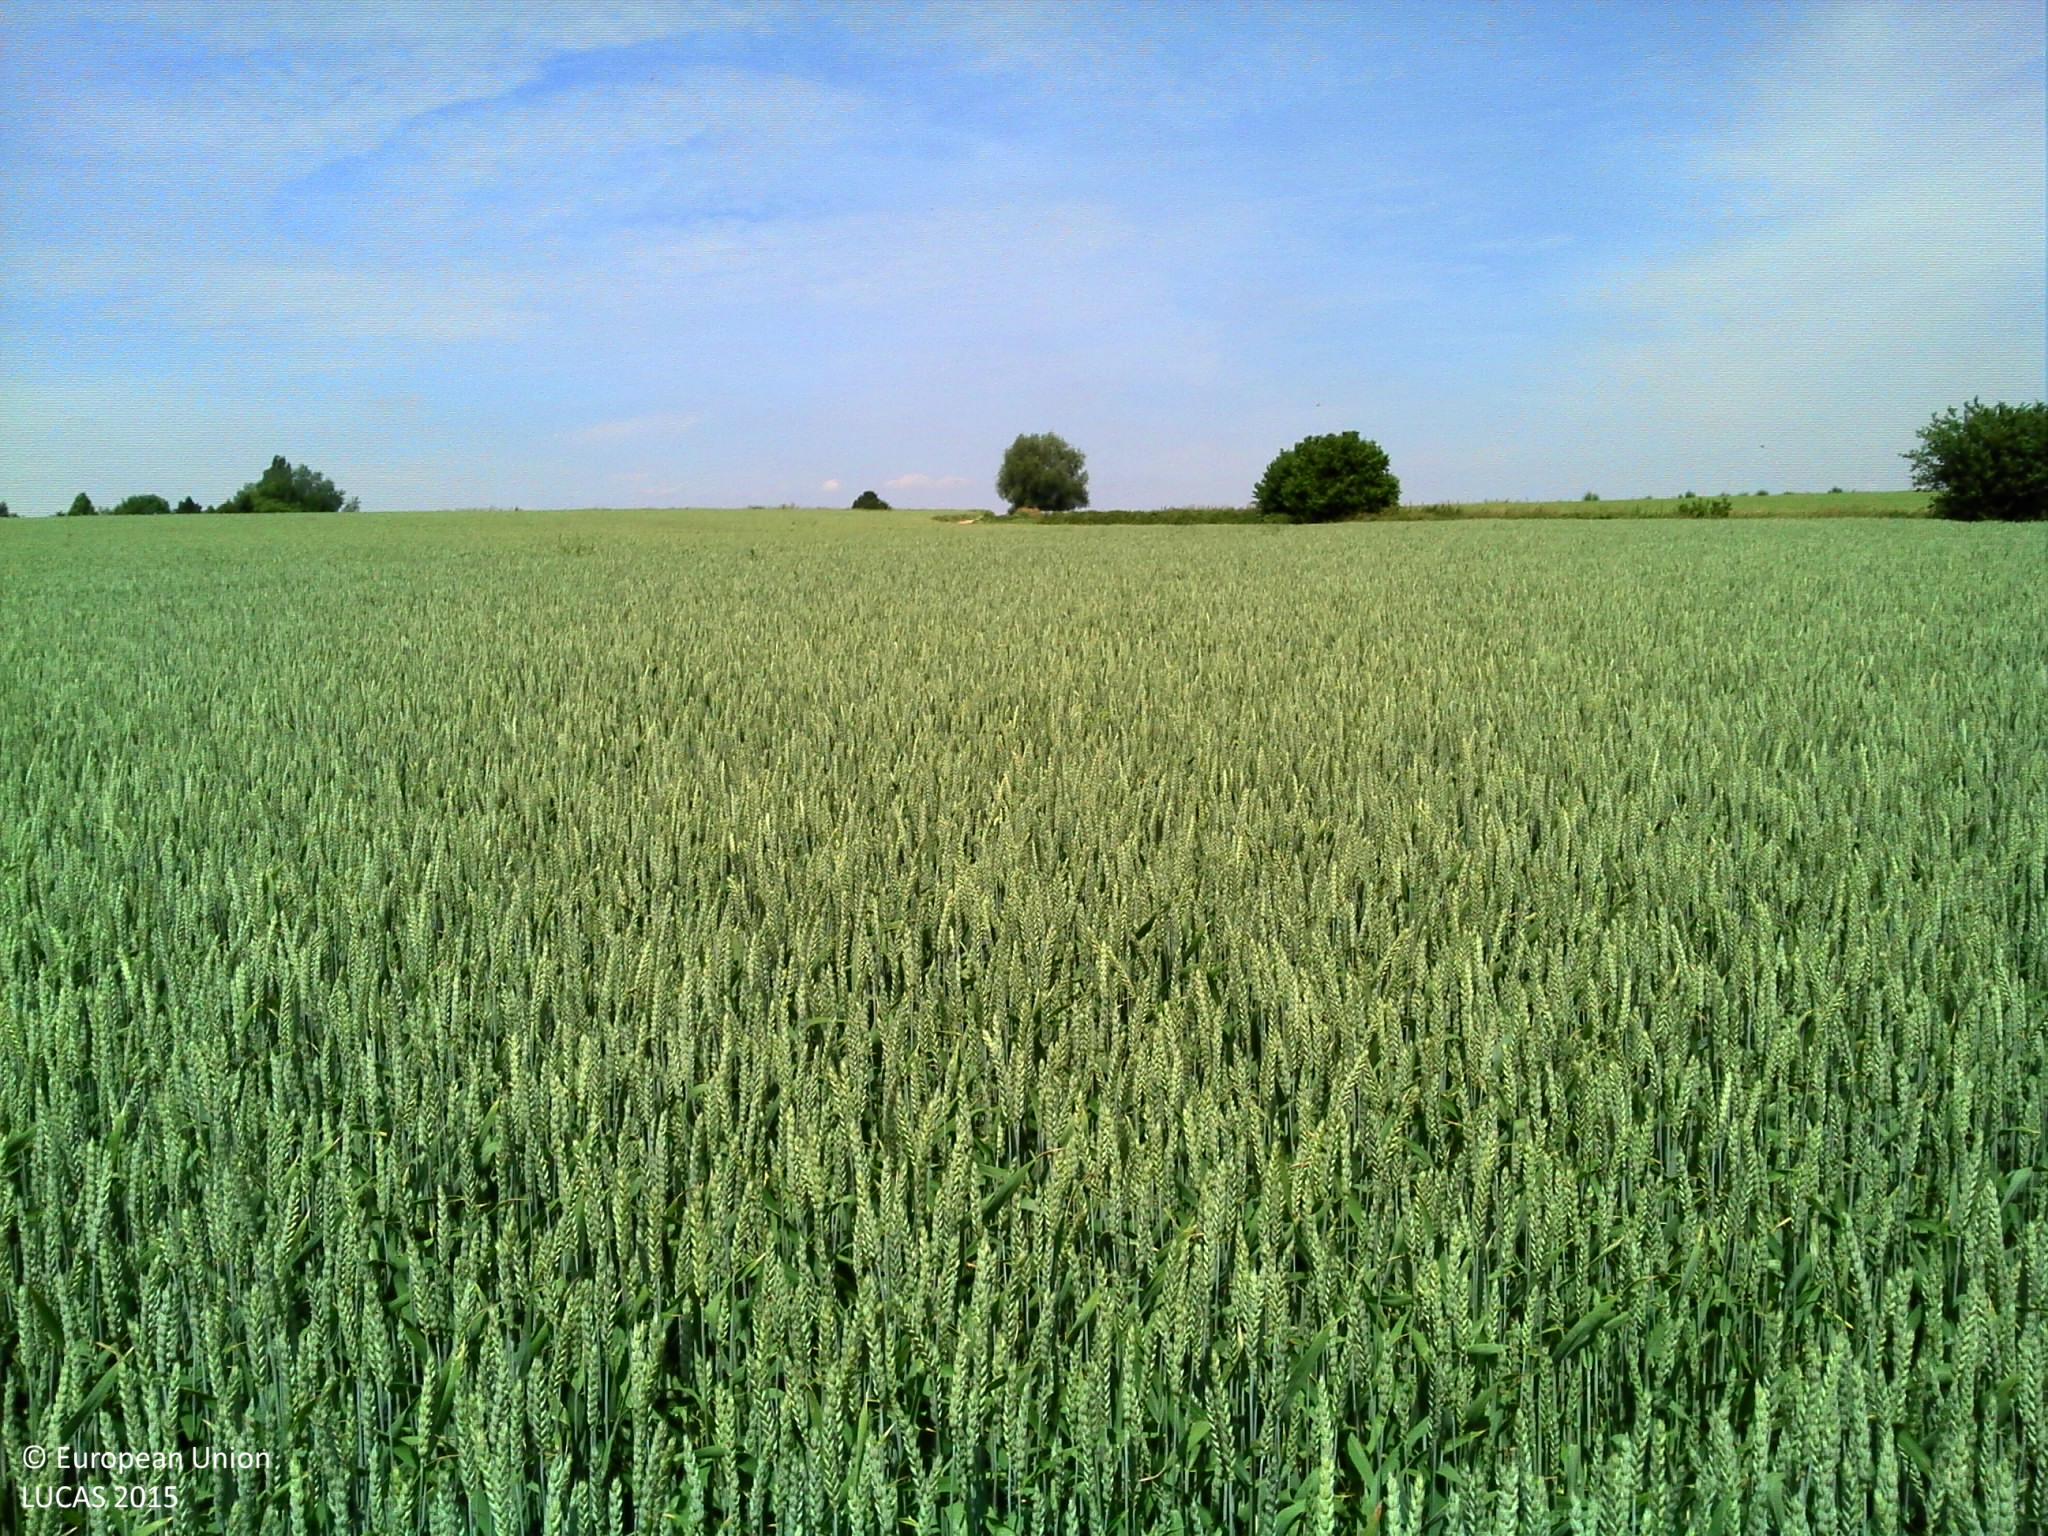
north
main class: Cropland
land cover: Common wheat
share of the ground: > 75 %
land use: Agriculture (excluding fallow land and kitchen gardens)
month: June
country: BE
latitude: 50.5814
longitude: 3.5951
